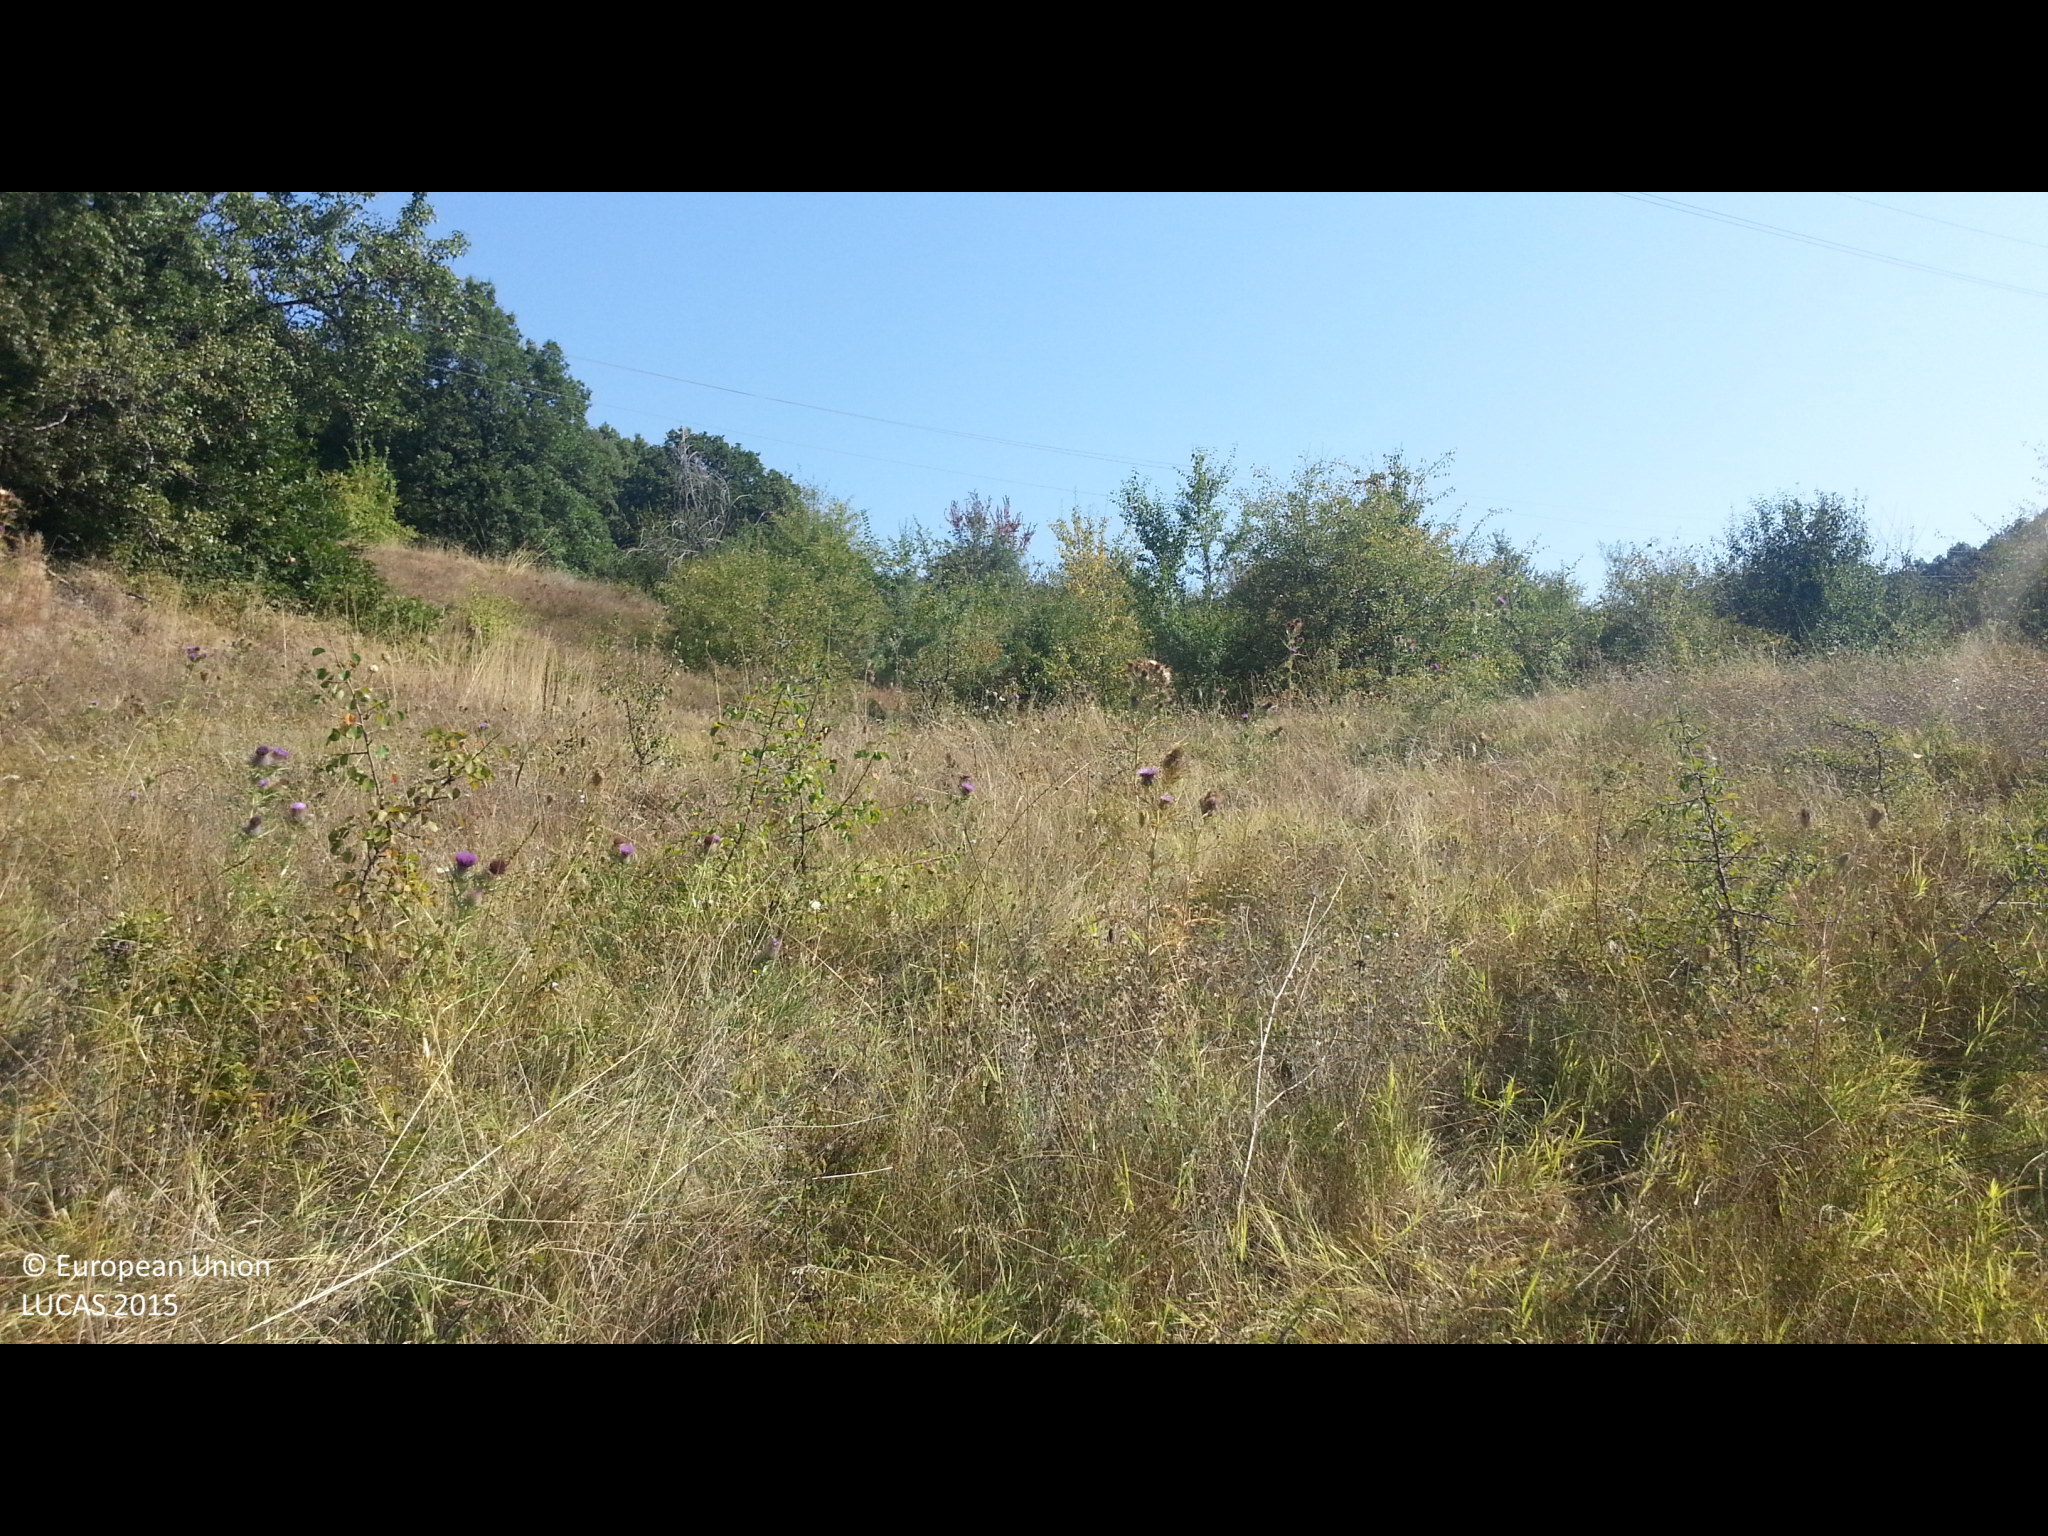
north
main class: Grassland
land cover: Grassland with sparse tree/shrub cover
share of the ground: > 75 %
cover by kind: herbaceous plants 95 %, broadleaved forest trees 5 %
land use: Semi-natural and natural areas not in use
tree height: < 5 m
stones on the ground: < 10 %
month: September
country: BG
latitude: 42.3805
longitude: 22.9856
